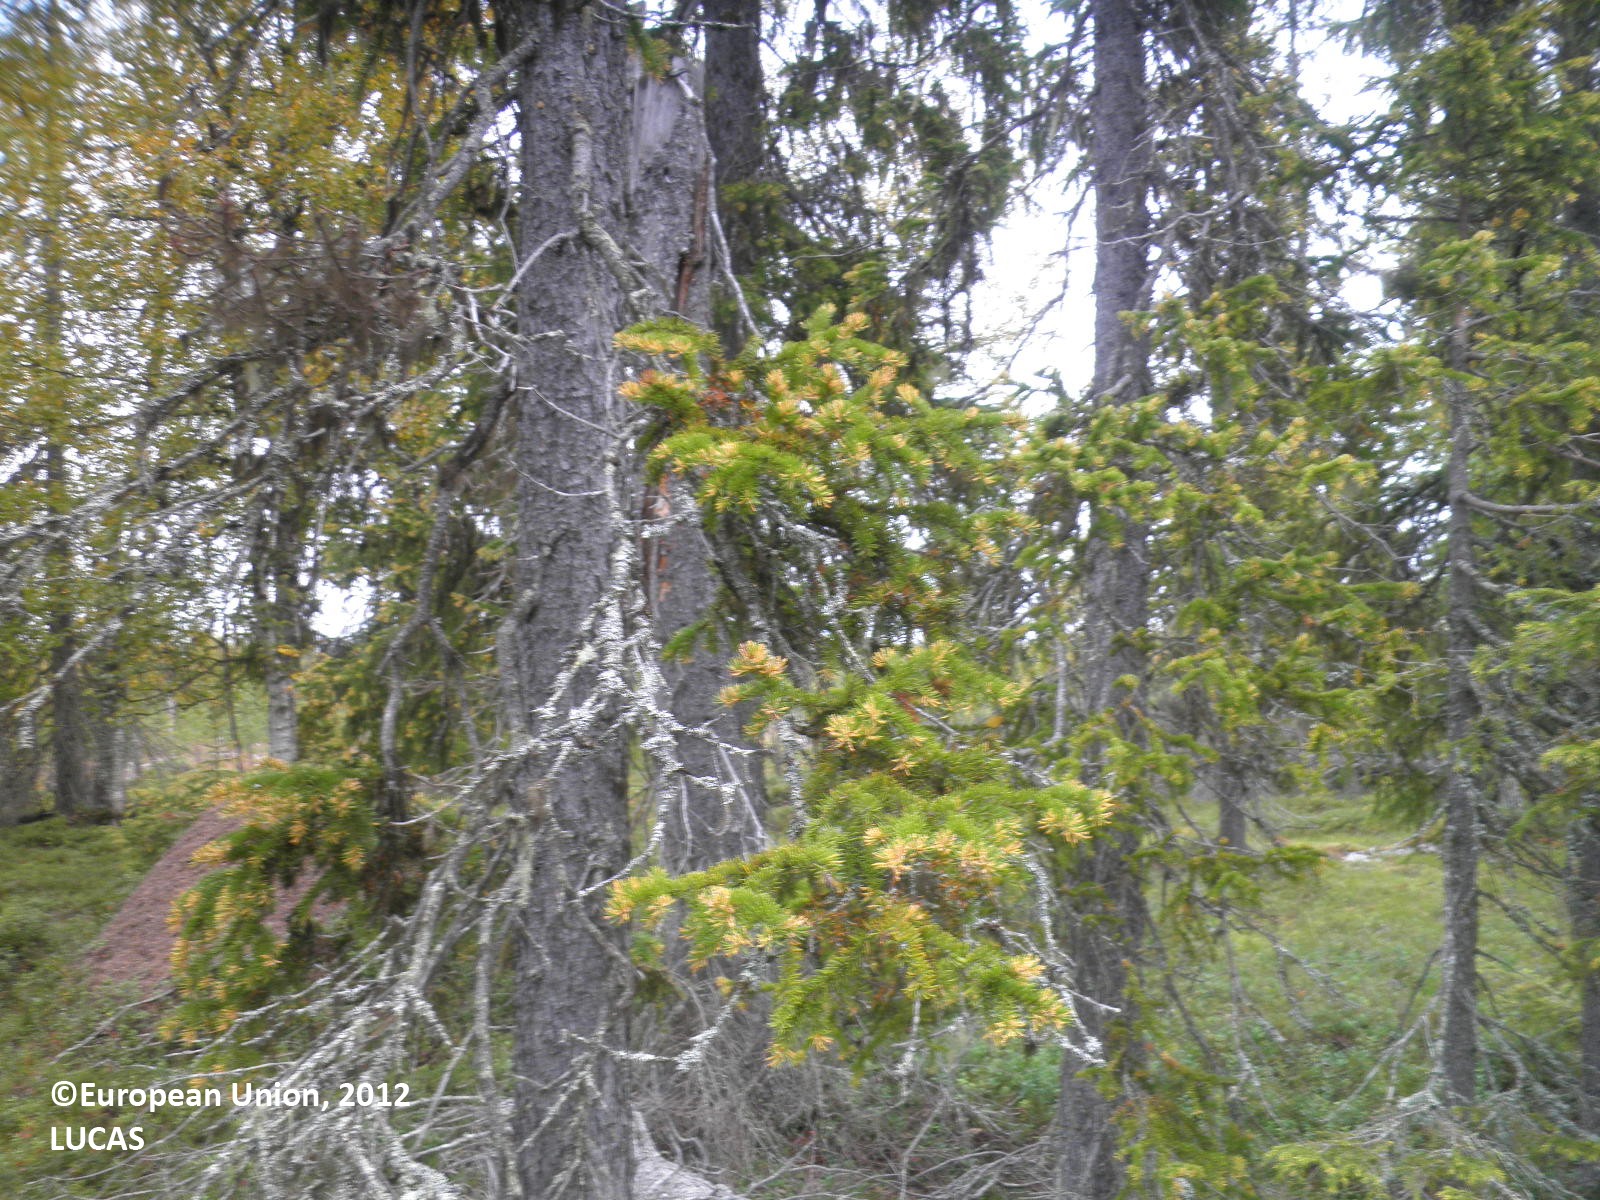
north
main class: Woodland
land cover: Spruce dominated mixed woodland
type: boreal forest
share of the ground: 50 - 75 %
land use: Forestry
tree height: > 5 m
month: August
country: FI
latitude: 67.5787
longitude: 27.9900
